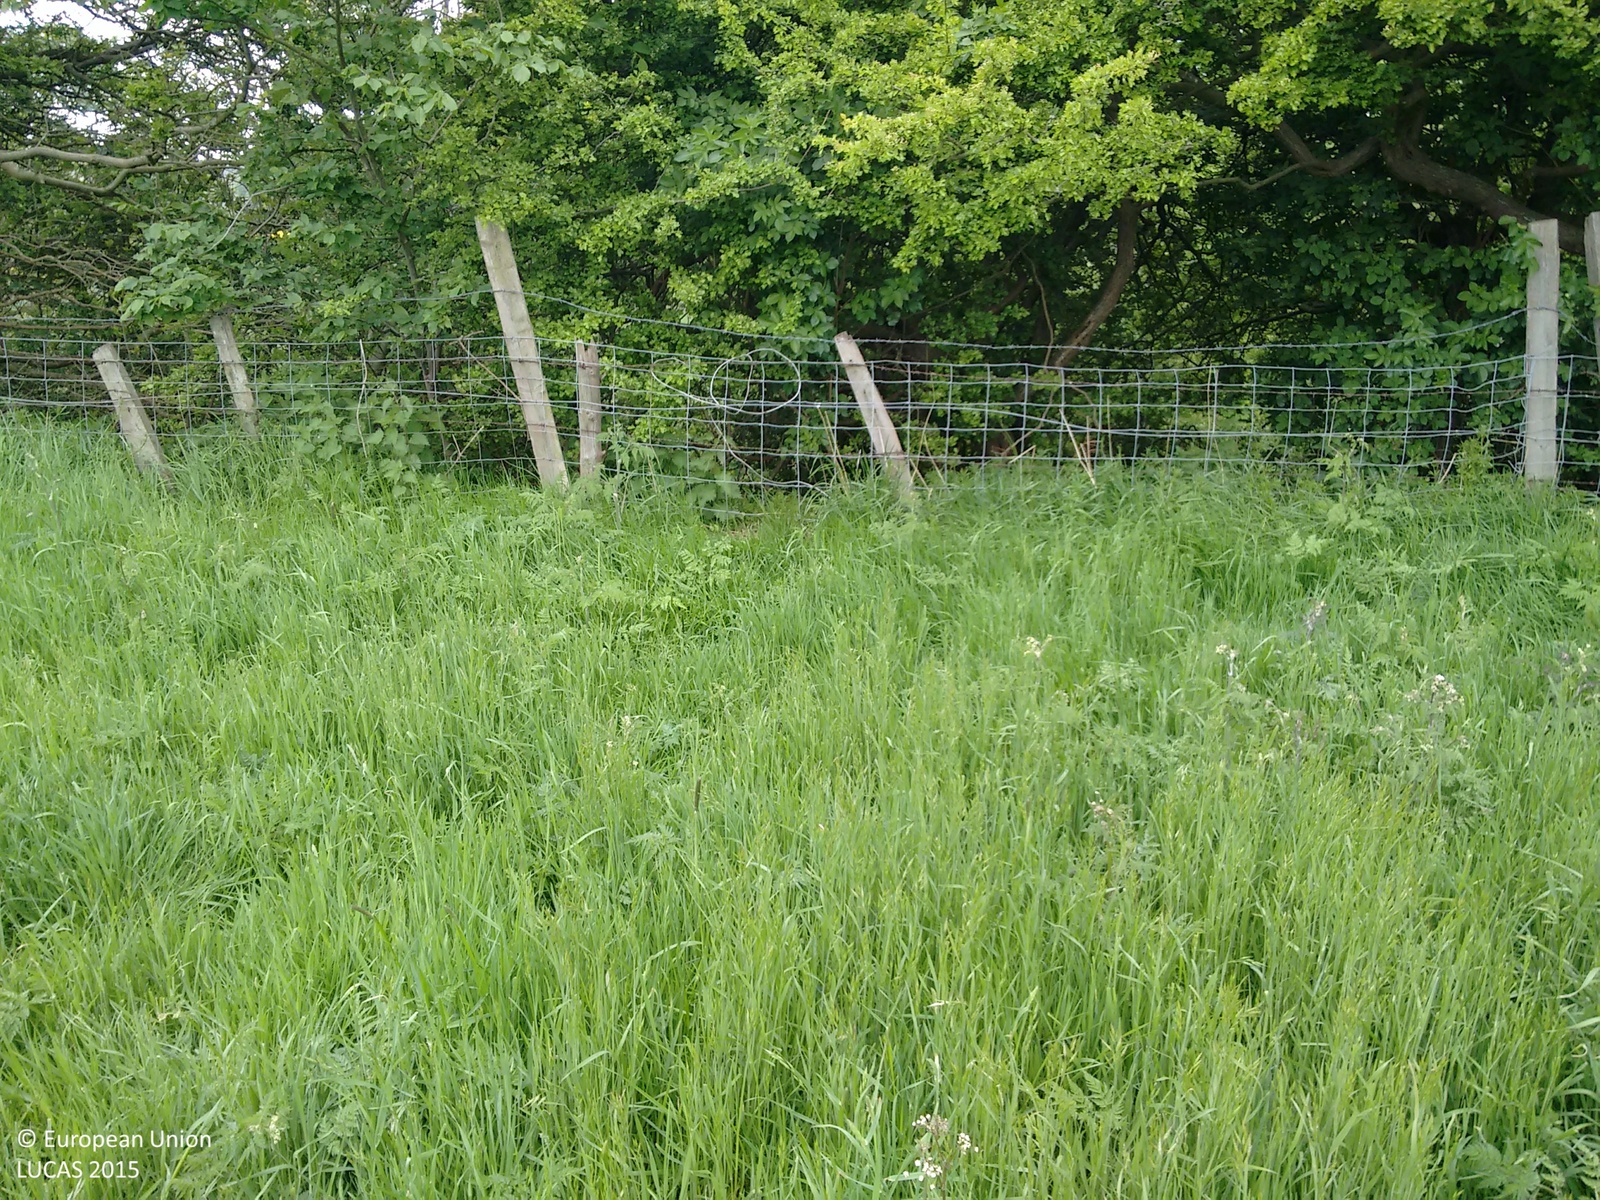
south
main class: Grassland
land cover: Grassland without tree/shrub cover
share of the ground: > 75 %
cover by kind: herbaceous plants 100 %
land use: Agriculture (excluding fallow land and kitchen gardens)
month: May
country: GB
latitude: 53.5157
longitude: -1.5883
